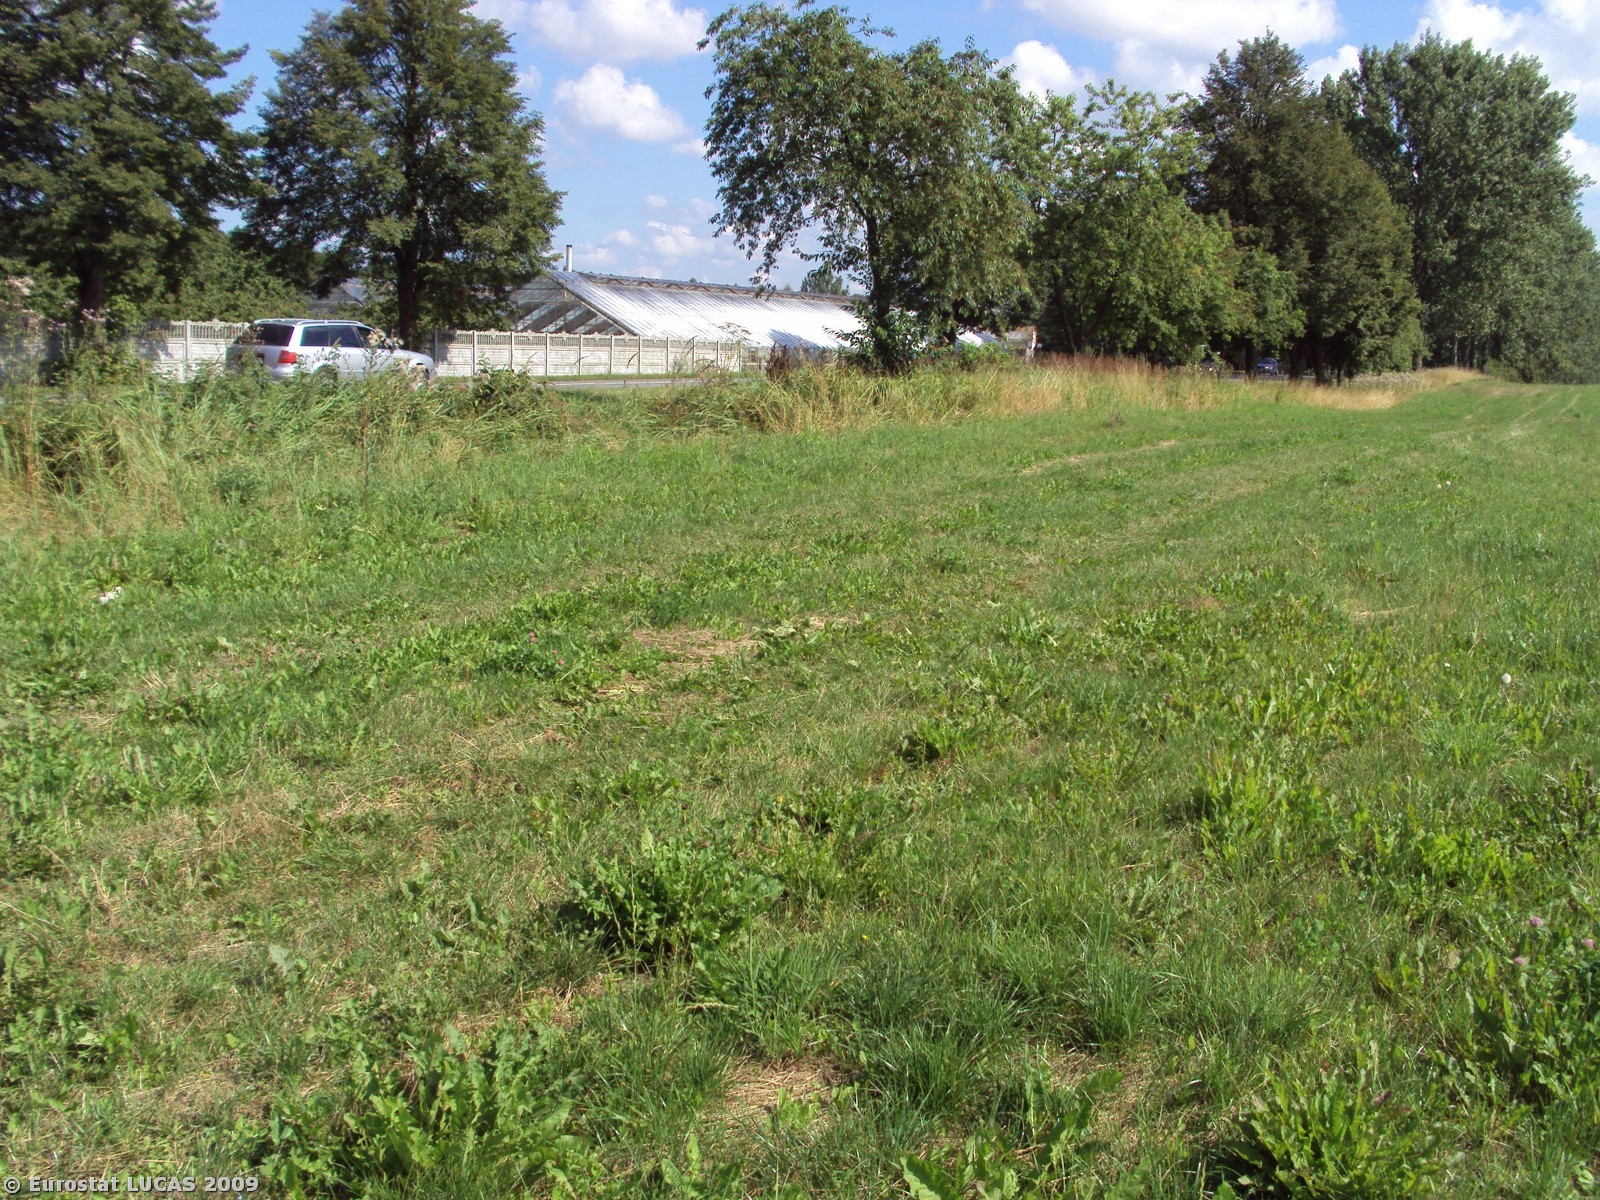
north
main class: Grassland
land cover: Grassland without tree/shrub cover
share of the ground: > 75 %
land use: Agriculture (excluding fallow land and kitchen gardens)
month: August
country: PL
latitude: 53.2504
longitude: 16.4063
